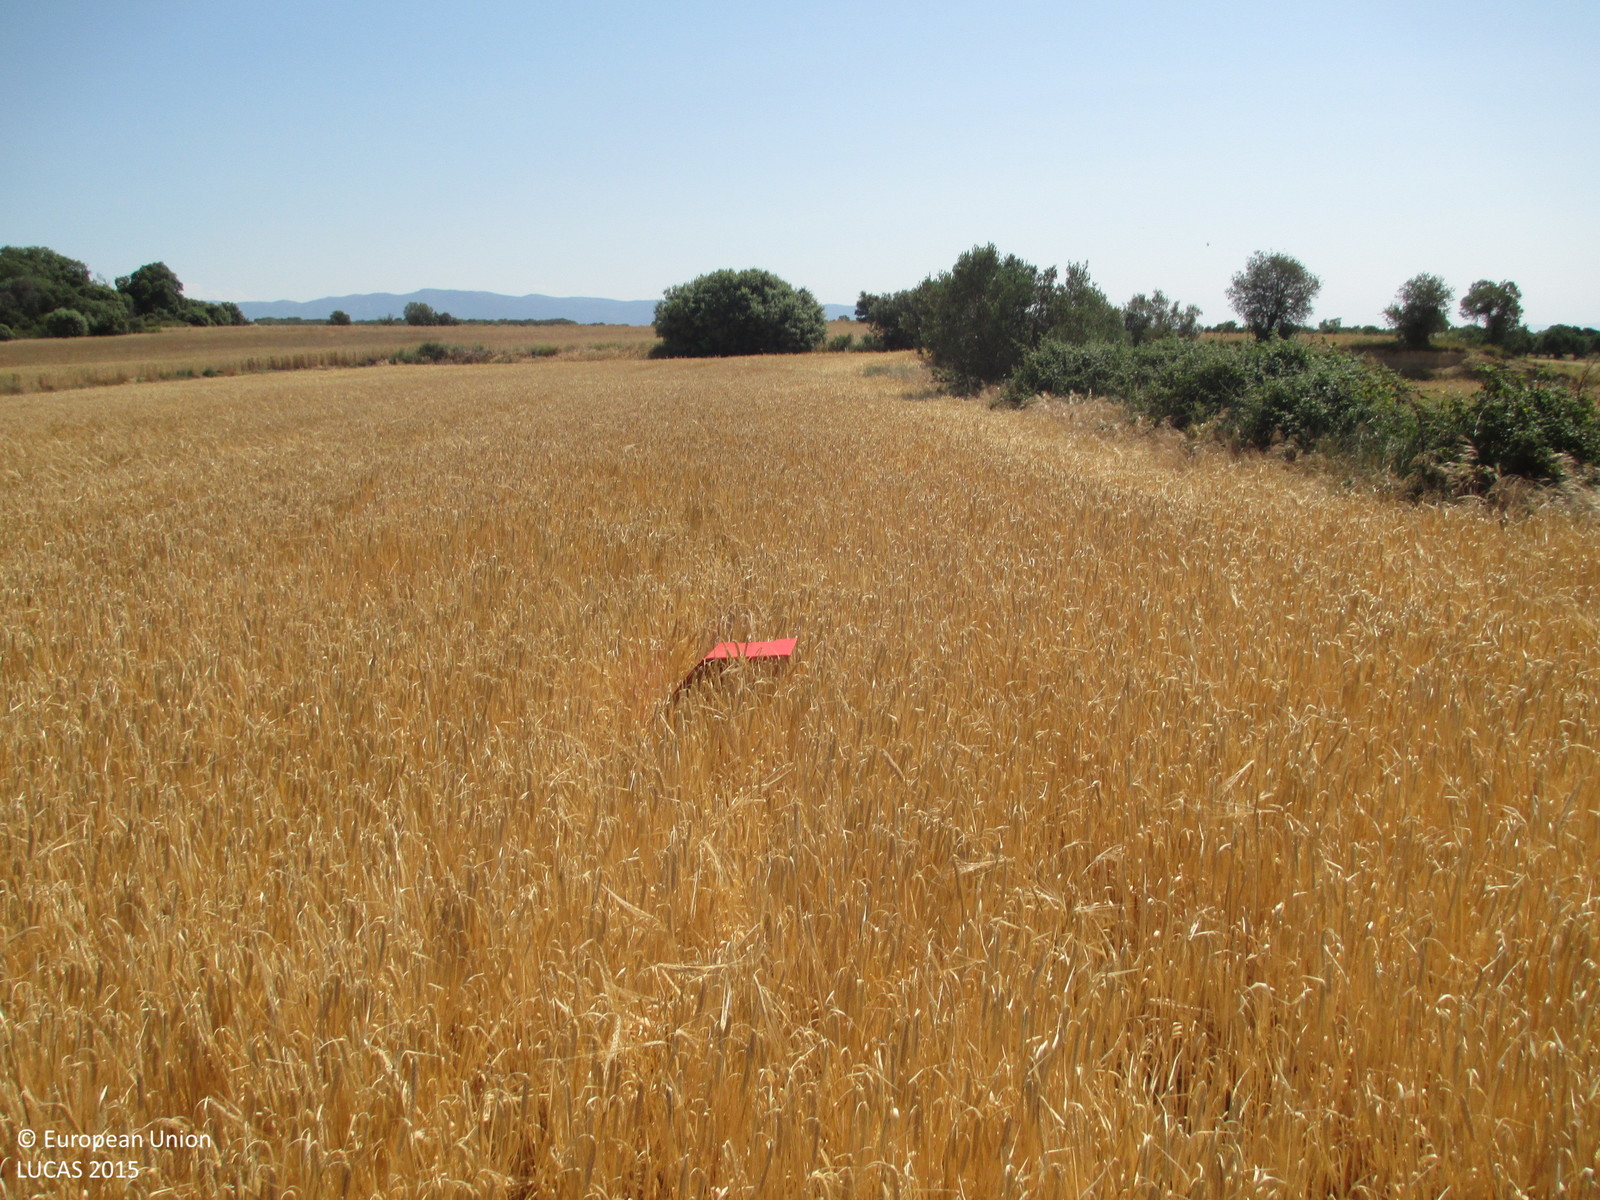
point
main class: Cropland
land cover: Barley
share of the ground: > 75 %
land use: Agriculture (excluding fallow land and kitchen gardens)
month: June
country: ES
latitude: 42.1561
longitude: -0.1994
